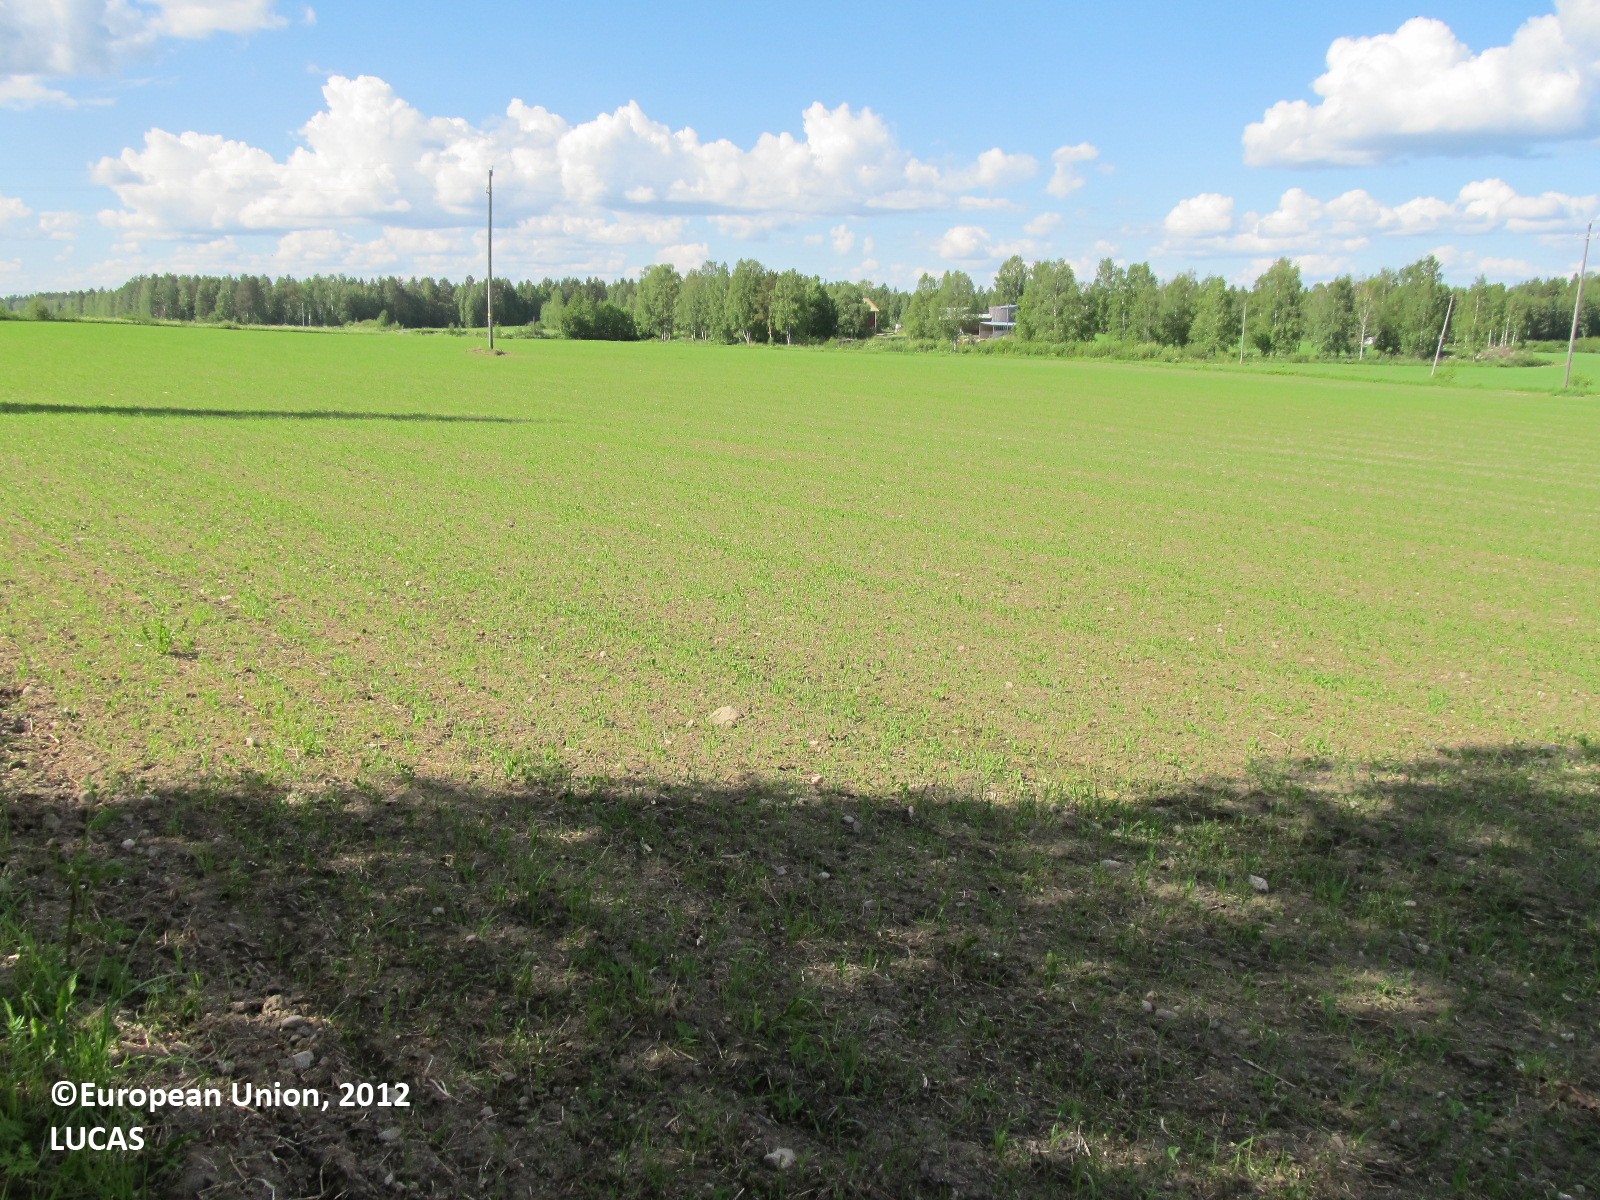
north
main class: Cropland
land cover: Temporary grasslands
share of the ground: 10 - 25 %
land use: Agriculture (excluding fallow land and kitchen gardens)
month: June
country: FI
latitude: 62.7406
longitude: 27.6860
